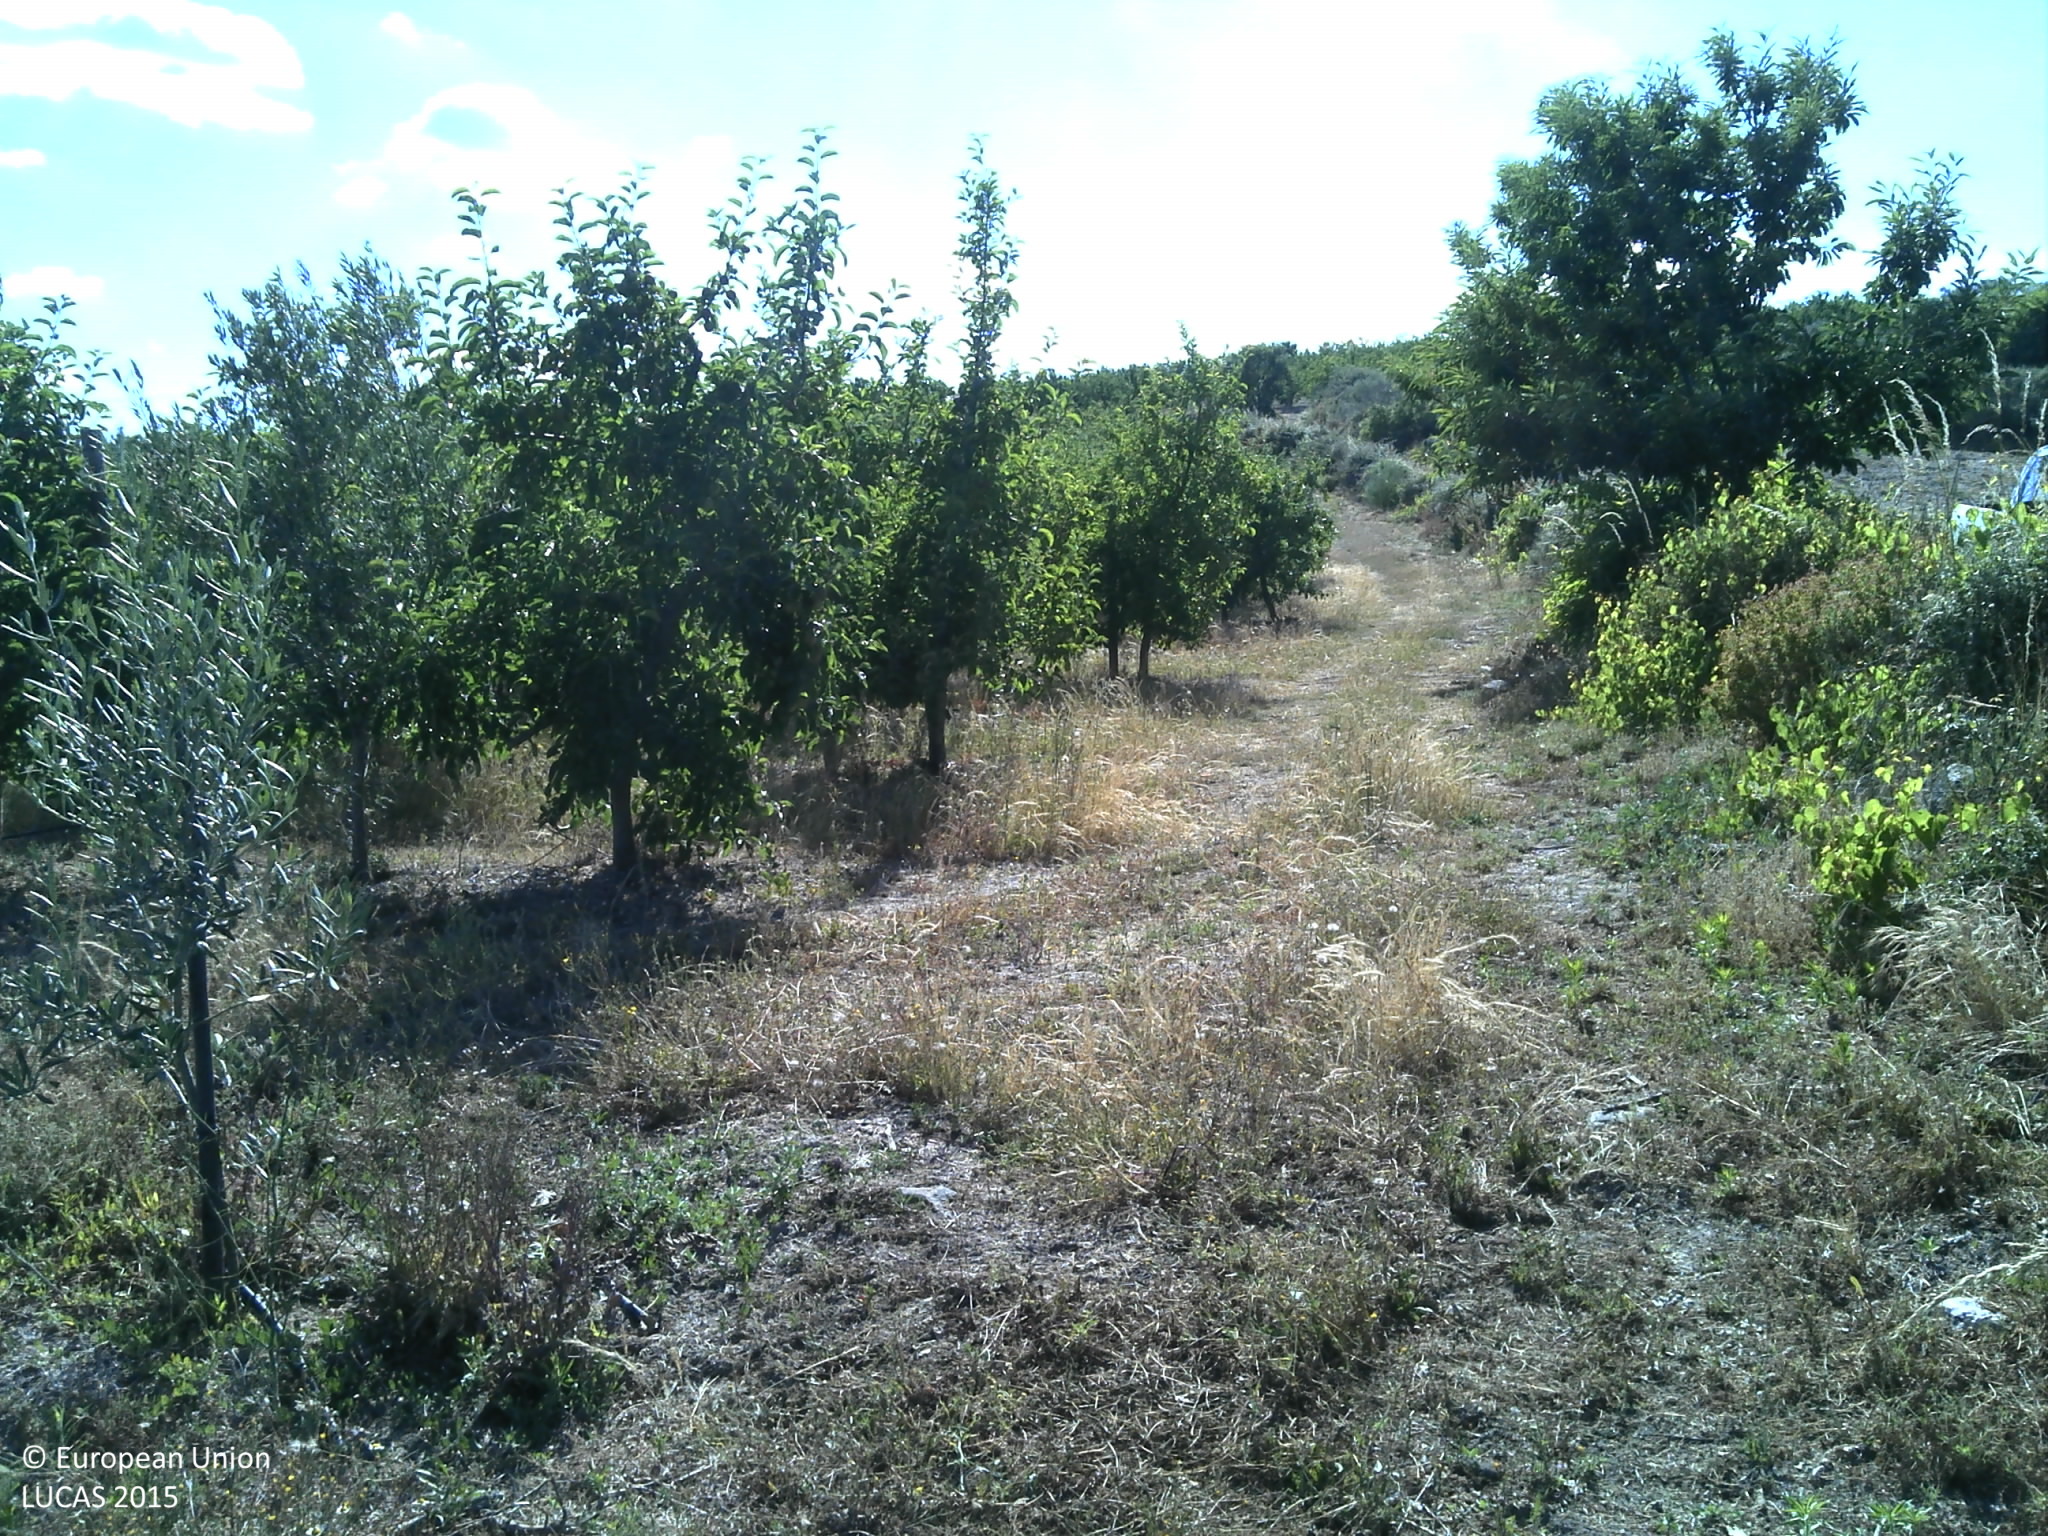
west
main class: Cropland
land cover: Olive groves
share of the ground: < 10 %
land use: Agriculture (excluding fallow land and kitchen gardens)
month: June
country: PT
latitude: 41.0167
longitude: -7.5417
